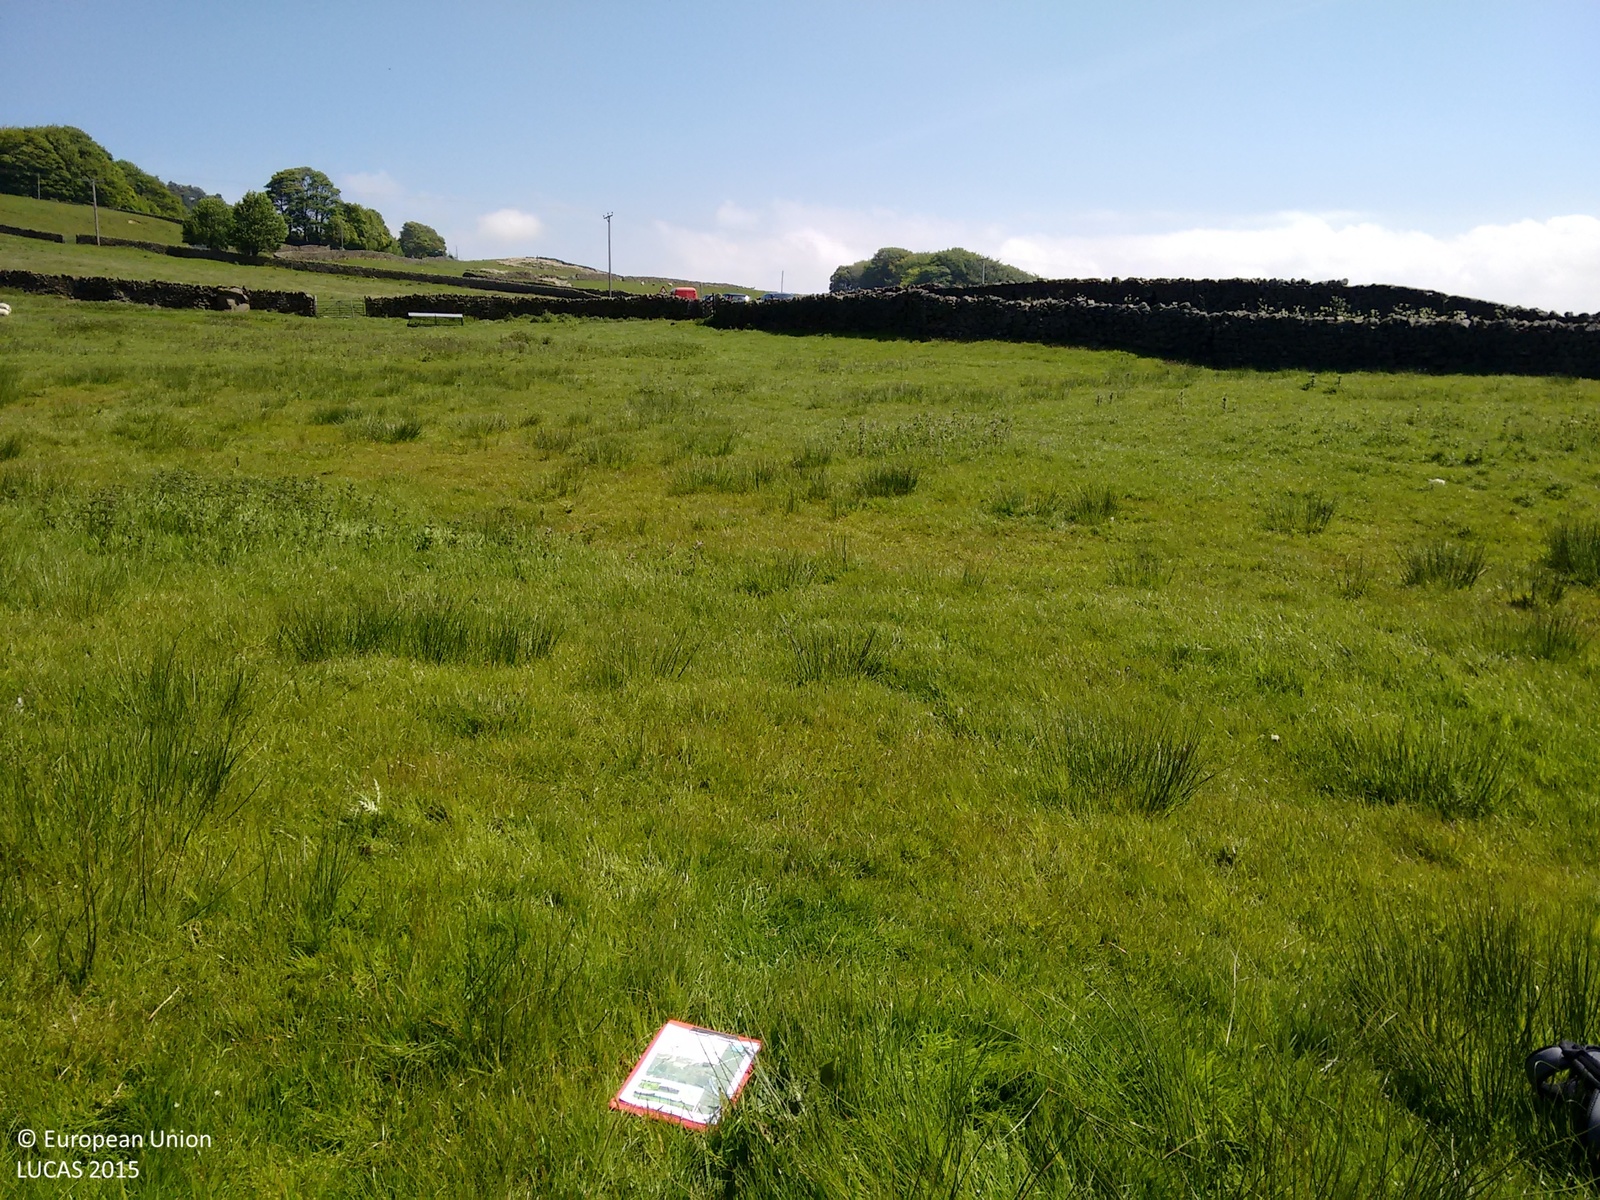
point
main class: Grassland
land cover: Grassland without tree/shrub cover
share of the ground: > 75 %
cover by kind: herbaceous plants 100 %
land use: Agriculture (excluding fallow land and kitchen gardens)
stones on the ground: < 10 %
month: June
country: GB
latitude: 53.9880
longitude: -1.9675
